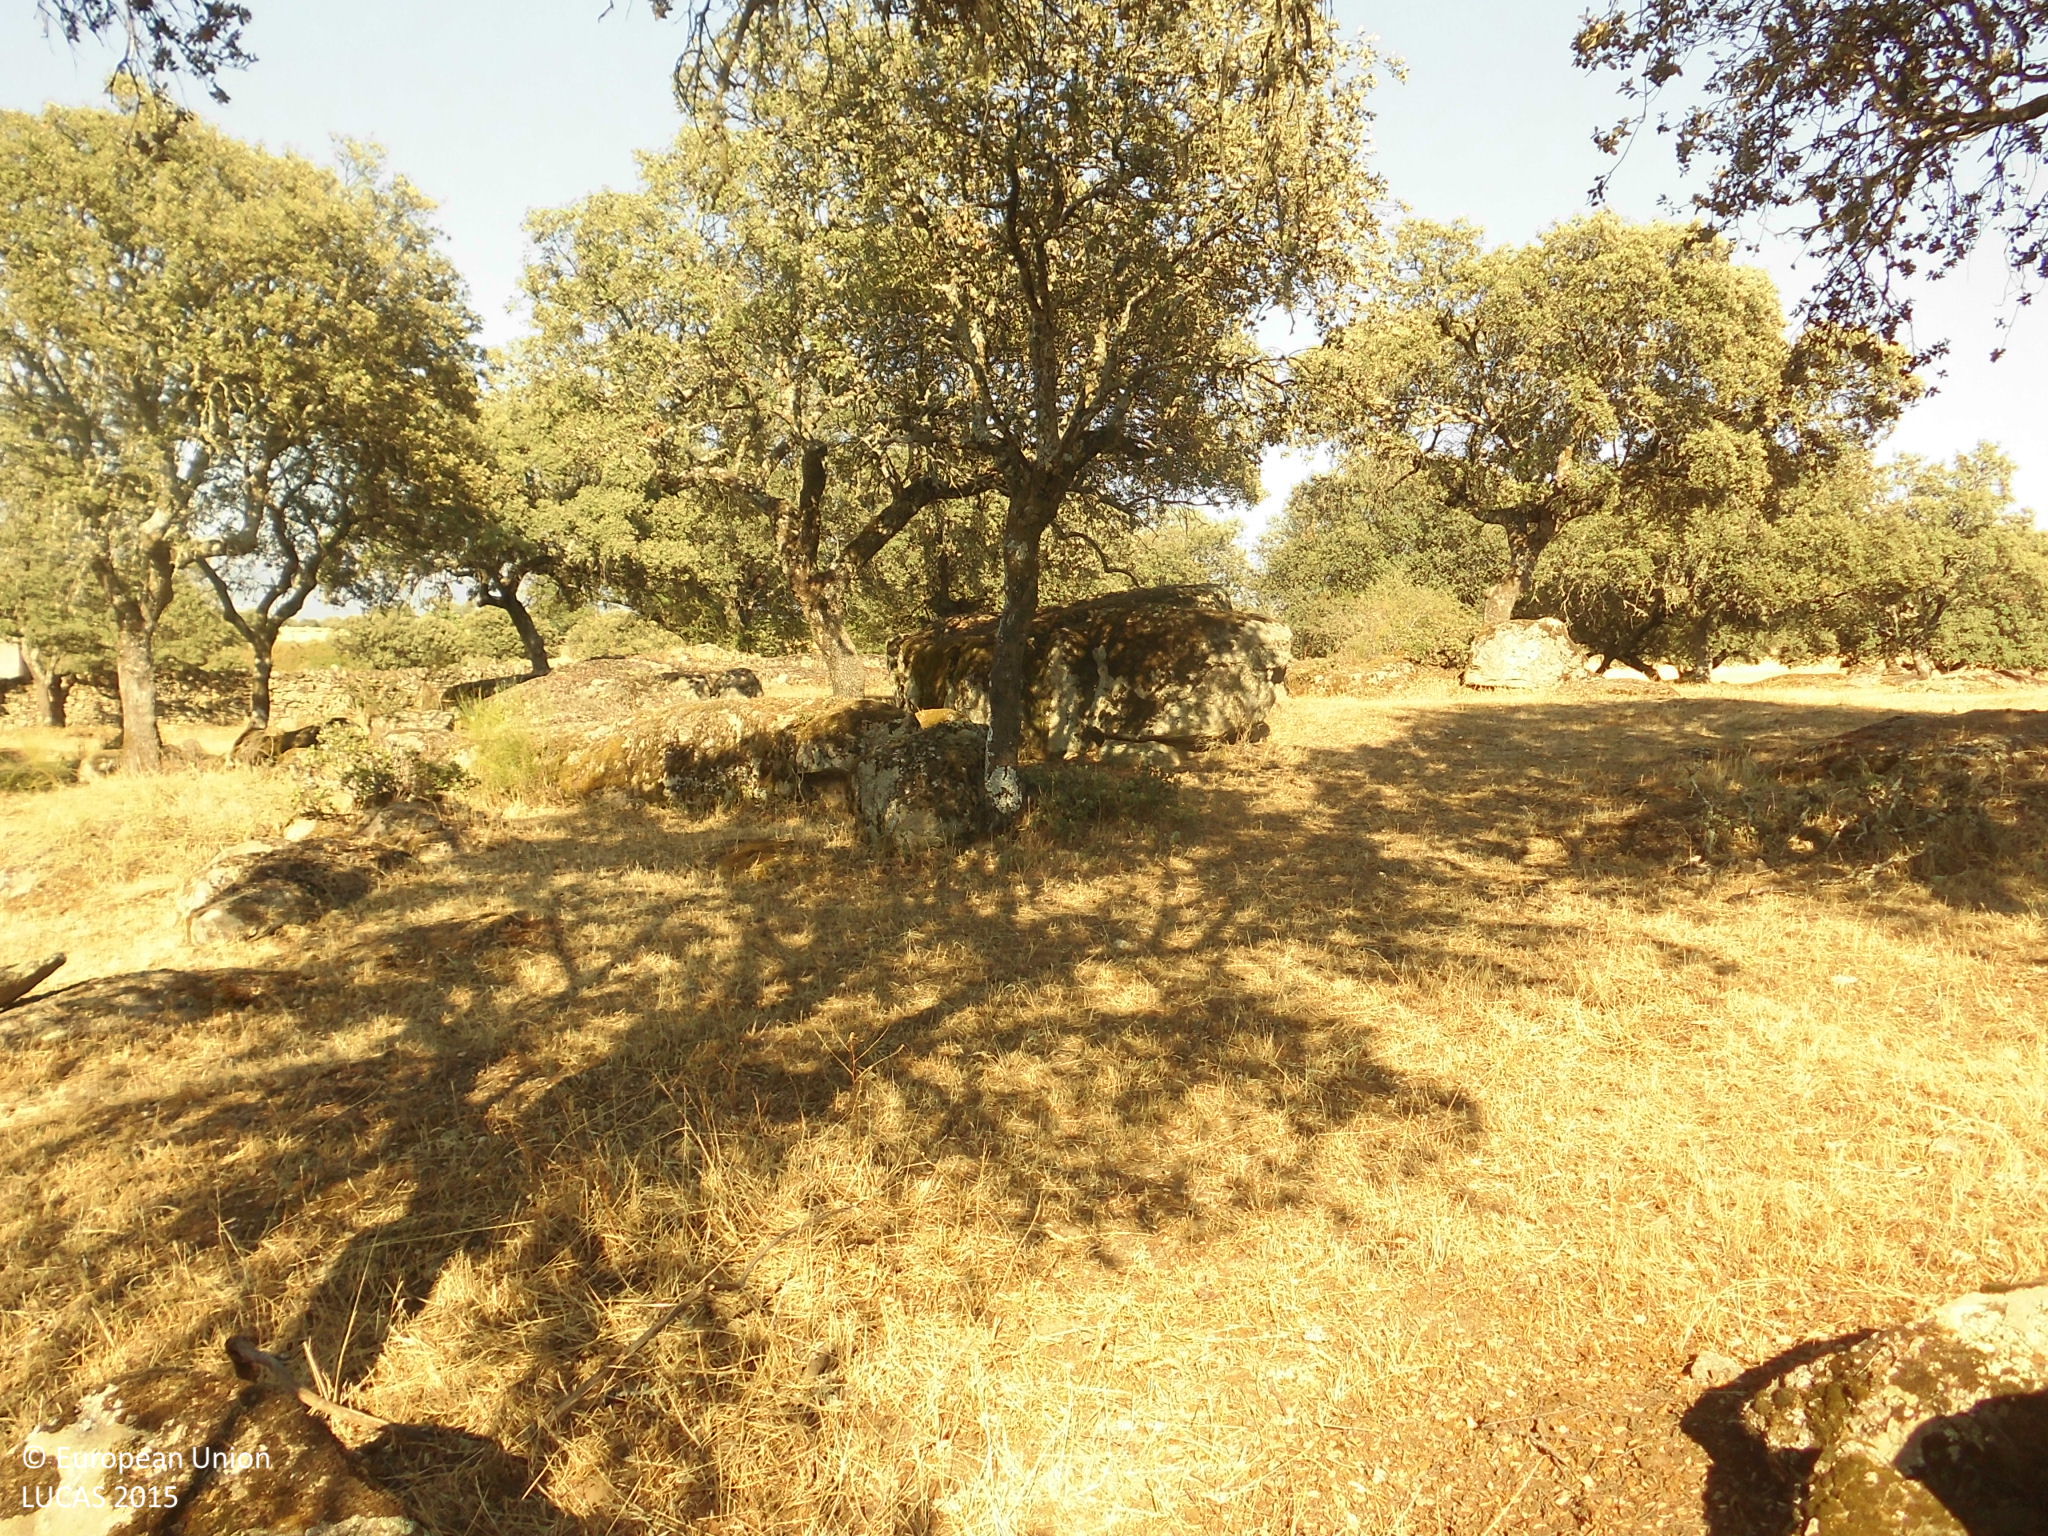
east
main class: Woodland
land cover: Broadleaved woodland
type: broadleaved evergreen forest
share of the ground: 25 - 50 %
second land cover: Grassland without tree/shrub cover
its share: > 75 %
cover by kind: herbaceous plants 70 %, broadleaved forest trees 30 %
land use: Forestry
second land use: Agriculture (excluding fallow land and kitchen gardens)
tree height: > 5 m
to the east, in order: Broadleaved woodland; Grassland without tree/shrub cover; Broadleaved woodland; Dry stone walls; Broadleaved woodland; Dry stone walls; Grassland with sparse tree/shrub cover; Ponds and wetlands; Grassland with sparse tree/shrub cover; Dry stone walls; Tracks; Dry stone walls; Grassland with sparse tree/shrub cover
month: July
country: ES
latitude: 40.1317
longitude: -6.1645
